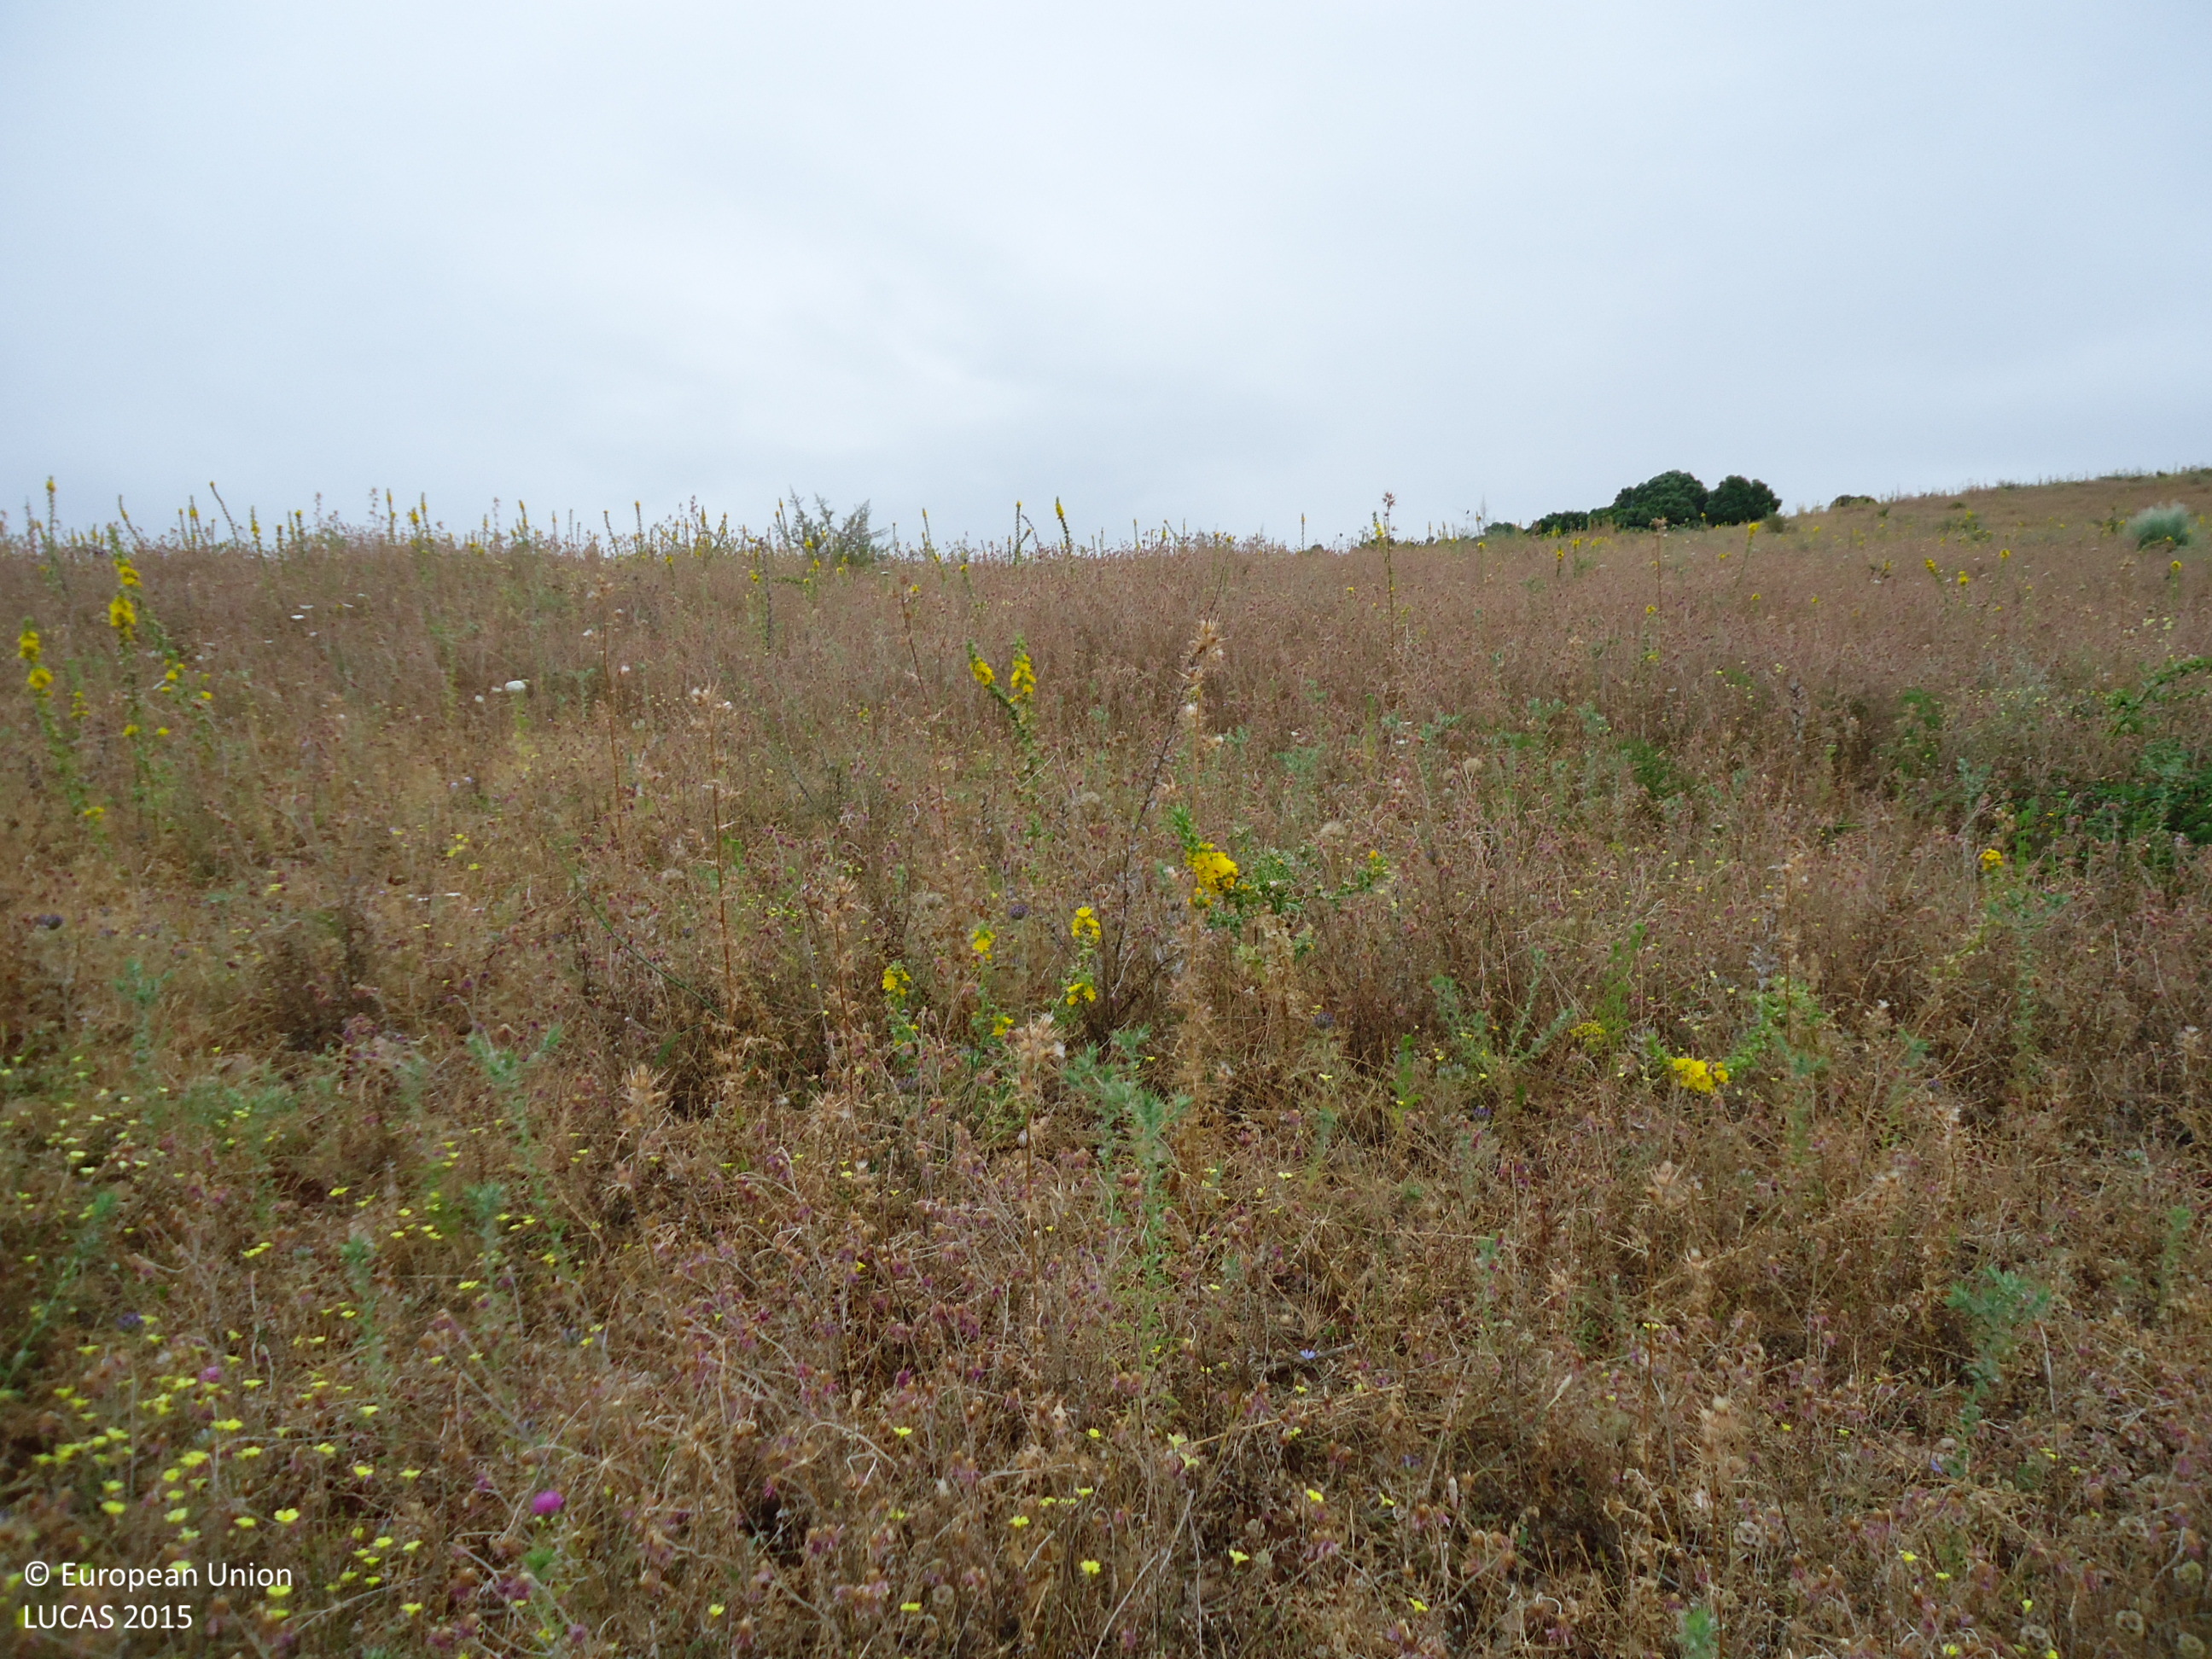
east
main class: Grassland
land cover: Spontaneously vegetated surfaces
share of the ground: > 75 %
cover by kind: herbaceous plants 100 %
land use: Agriculture (excluding fallow land and kitchen gardens)
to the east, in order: Spontaneously vegetated surfaces; Tracks; Spontaneously vegetated surfaces; Broadleaved woodland
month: June
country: ES
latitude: 36.4368
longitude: -5.3568
